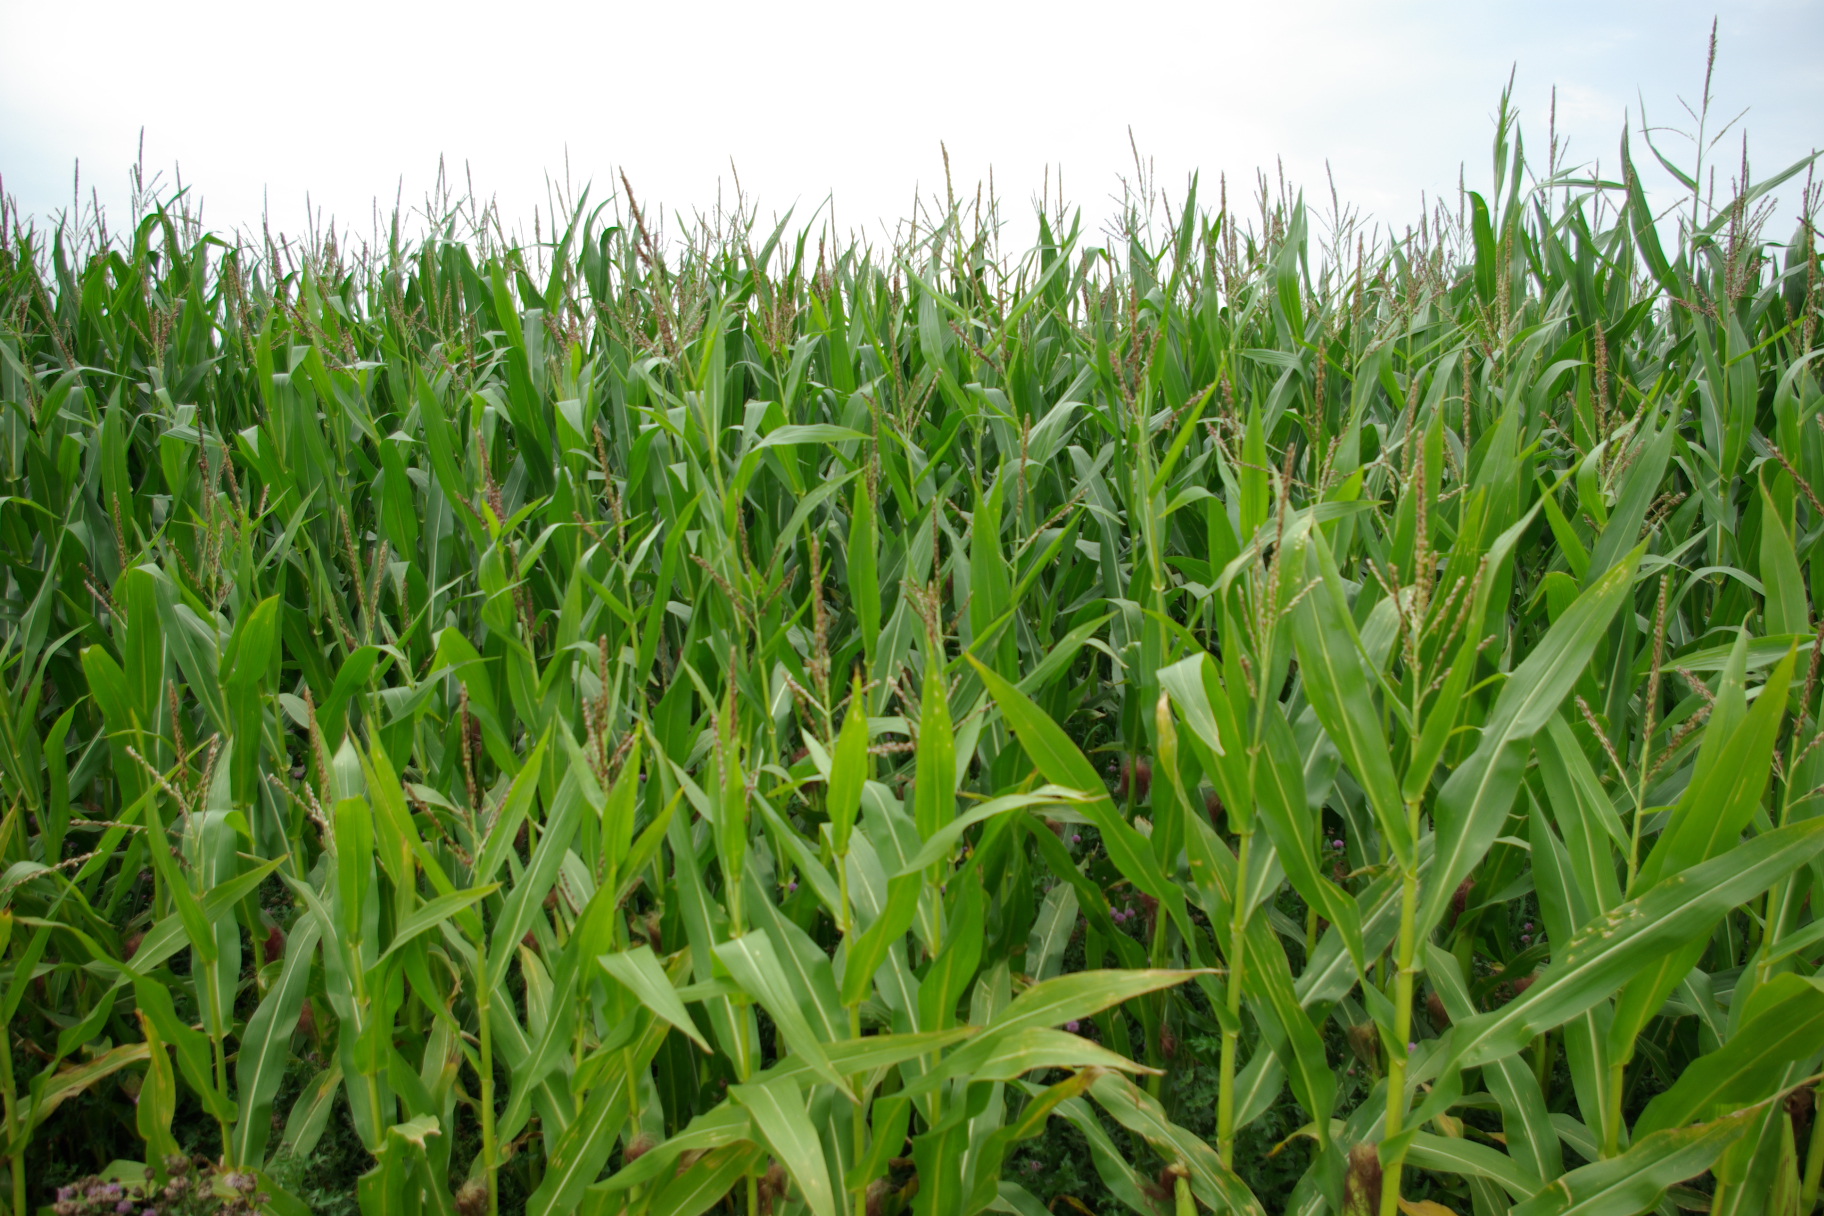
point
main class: Cropland
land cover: Maize
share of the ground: > 75 %
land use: Agriculture (excluding fallow land and kitchen gardens)
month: August
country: DE
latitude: 54.4963
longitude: 9.3057
